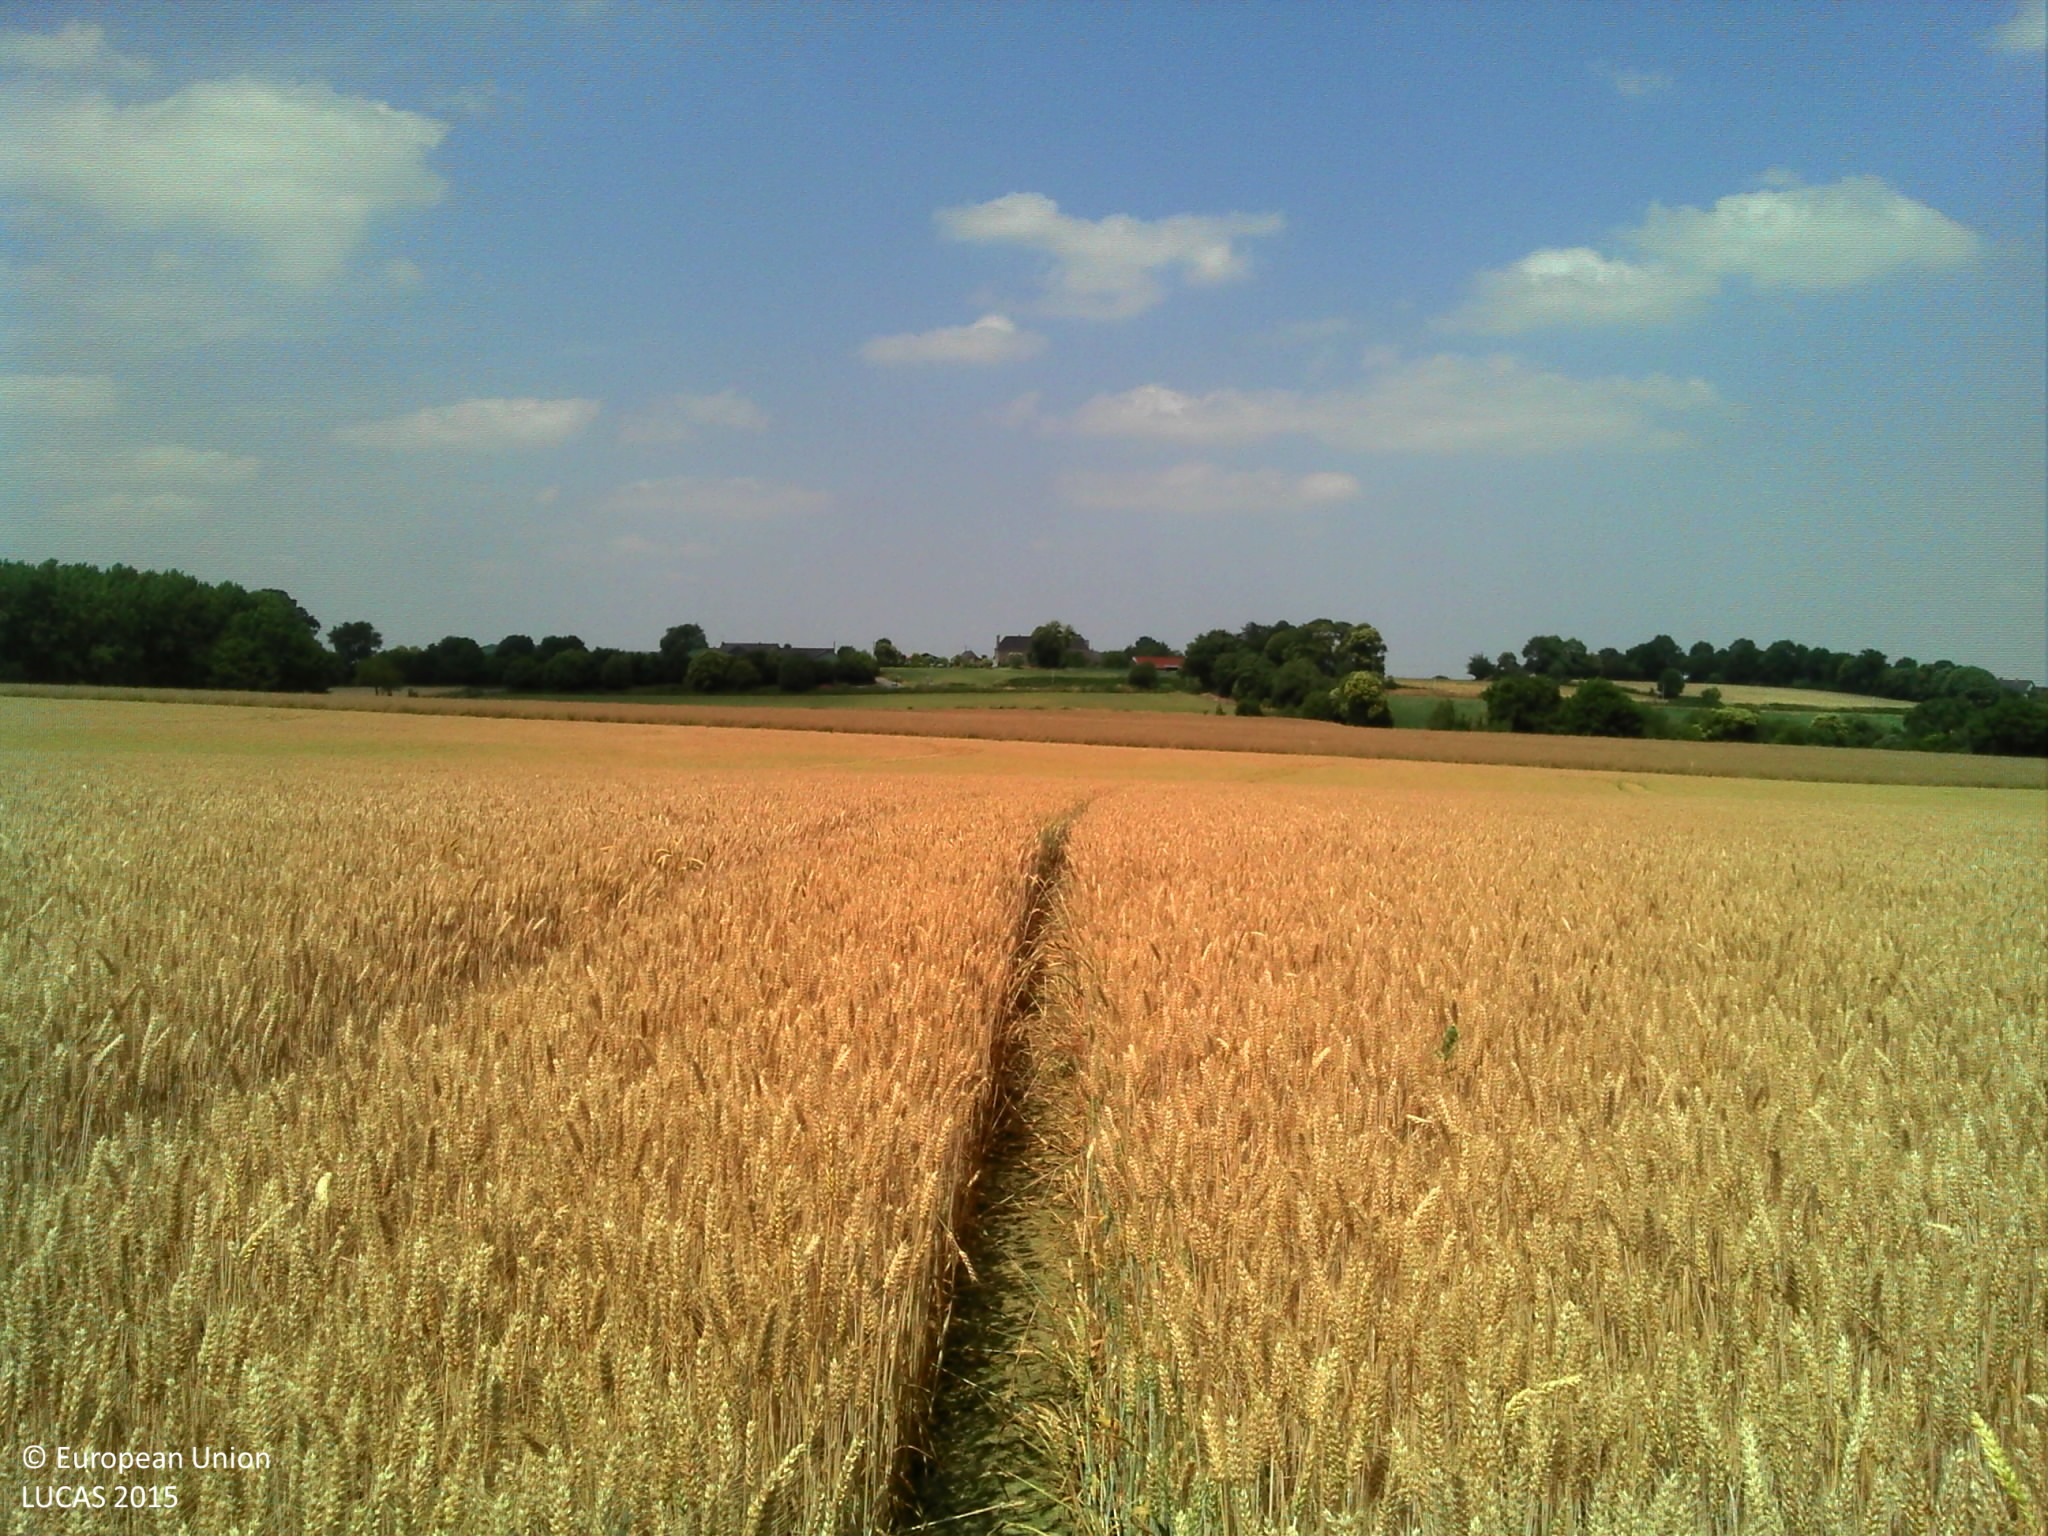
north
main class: Cropland
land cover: Durum wheat
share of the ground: > 75 %
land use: Agriculture (excluding fallow land and kitchen gardens)
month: July
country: FR
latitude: 47.9805
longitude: -1.1742
